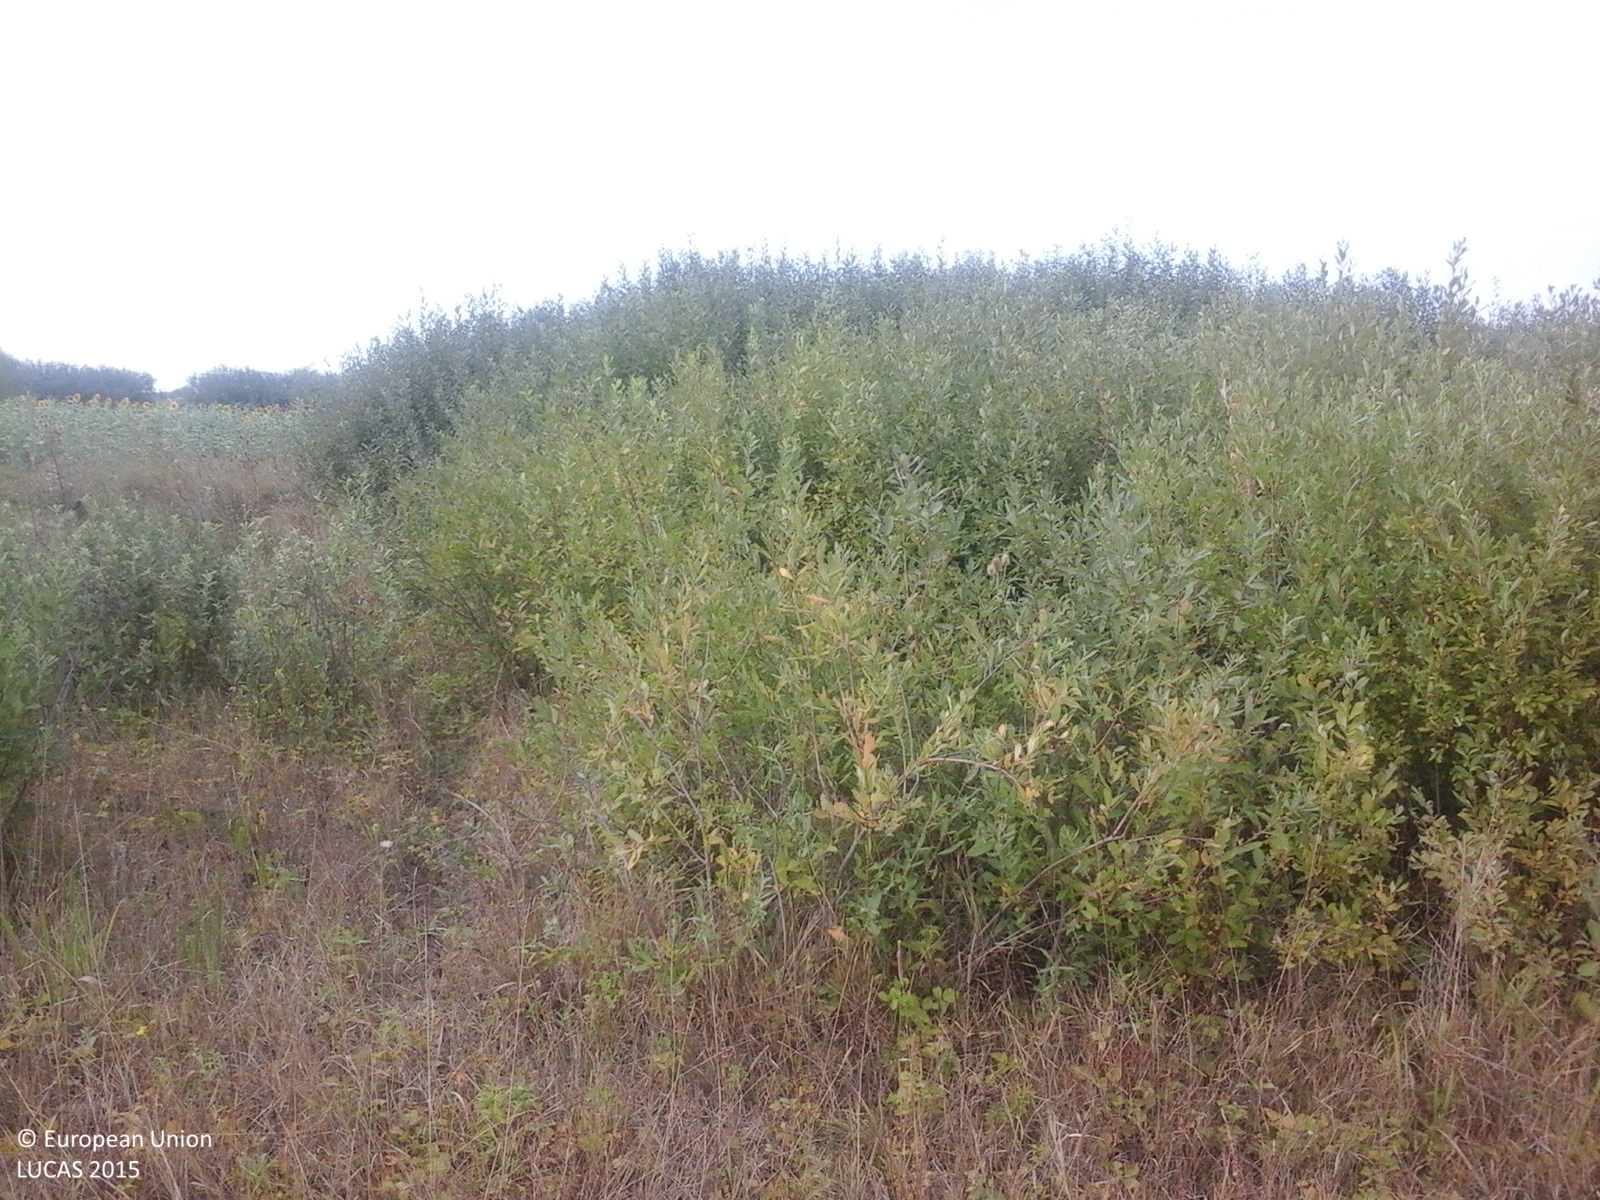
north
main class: Grassland
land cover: Grassland with sparse tree/shrub cover
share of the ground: > 75 %
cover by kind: herbaceous plants 85 %, shrubs 10 %, broadleaved forest trees 5 %
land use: Fallow land
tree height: < 5 m
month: August
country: RO
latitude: 46.5365
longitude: 21.7634
